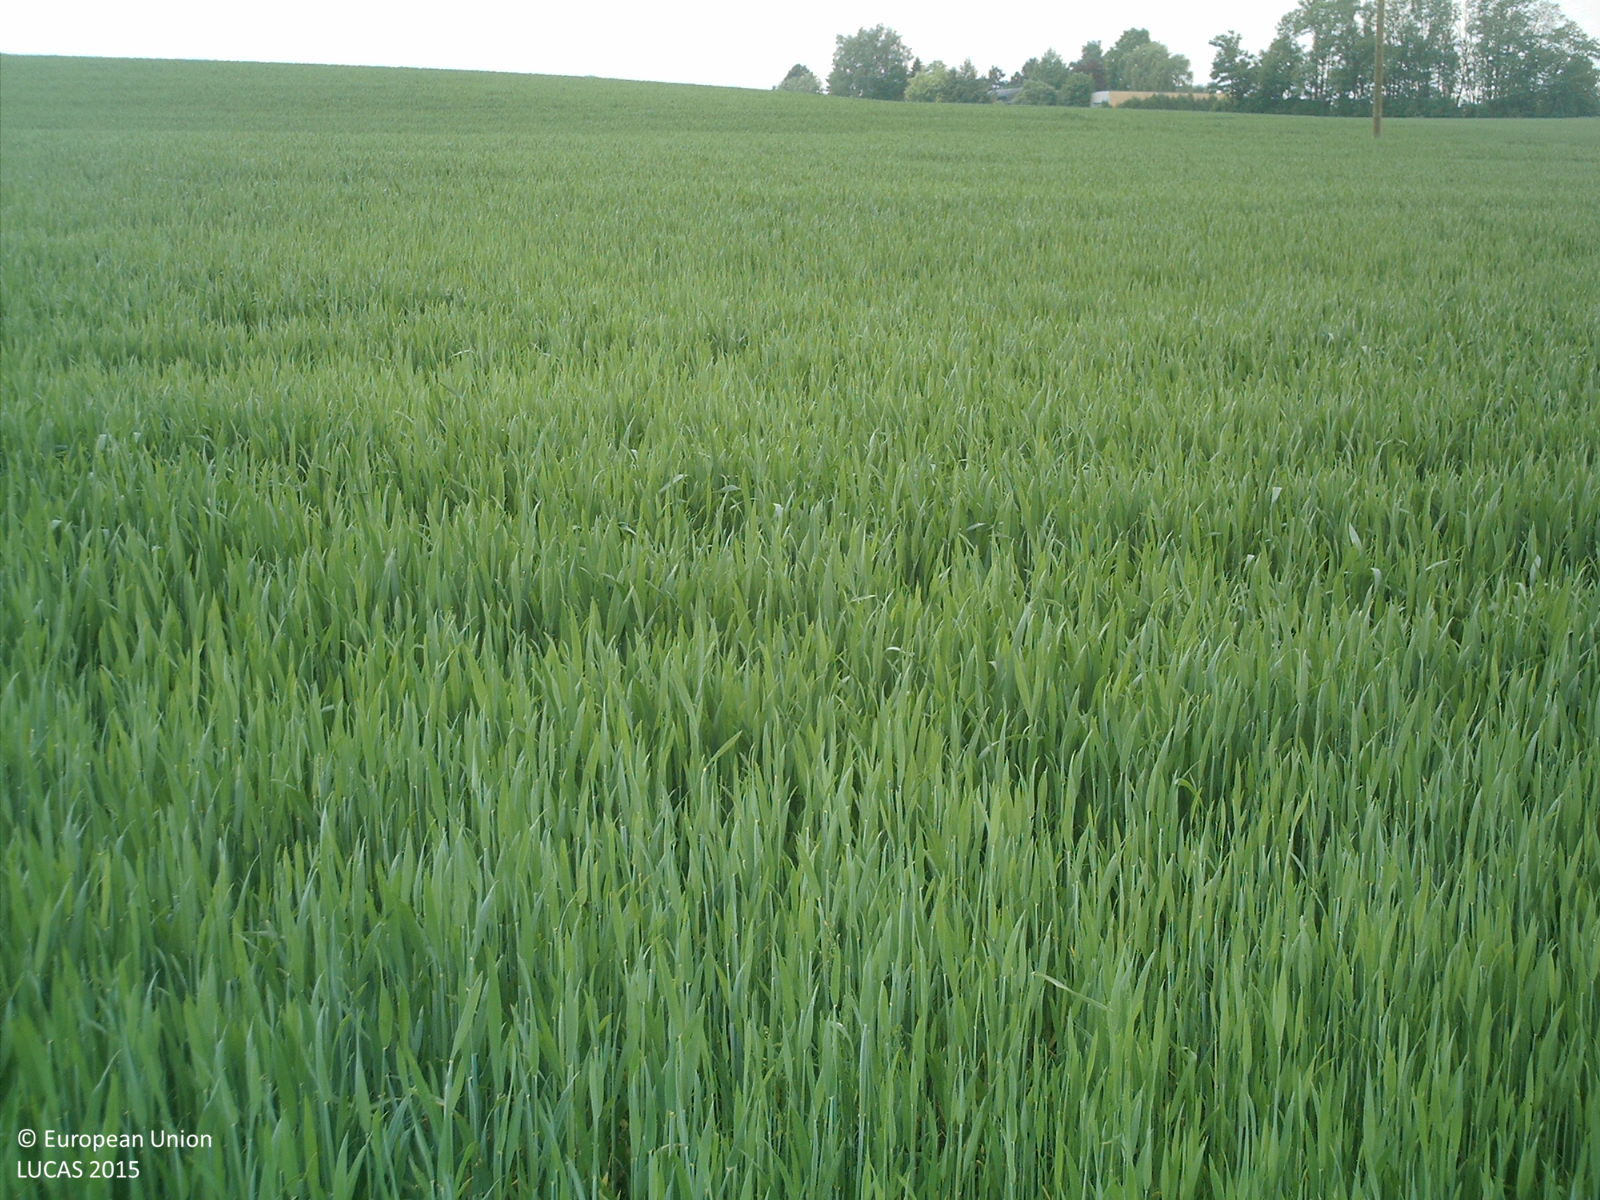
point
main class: Cropland
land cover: Common wheat
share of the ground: > 75 %
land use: Agriculture (excluding fallow land and kitchen gardens)
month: May
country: AT
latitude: 48.0735
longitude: 14.1470
